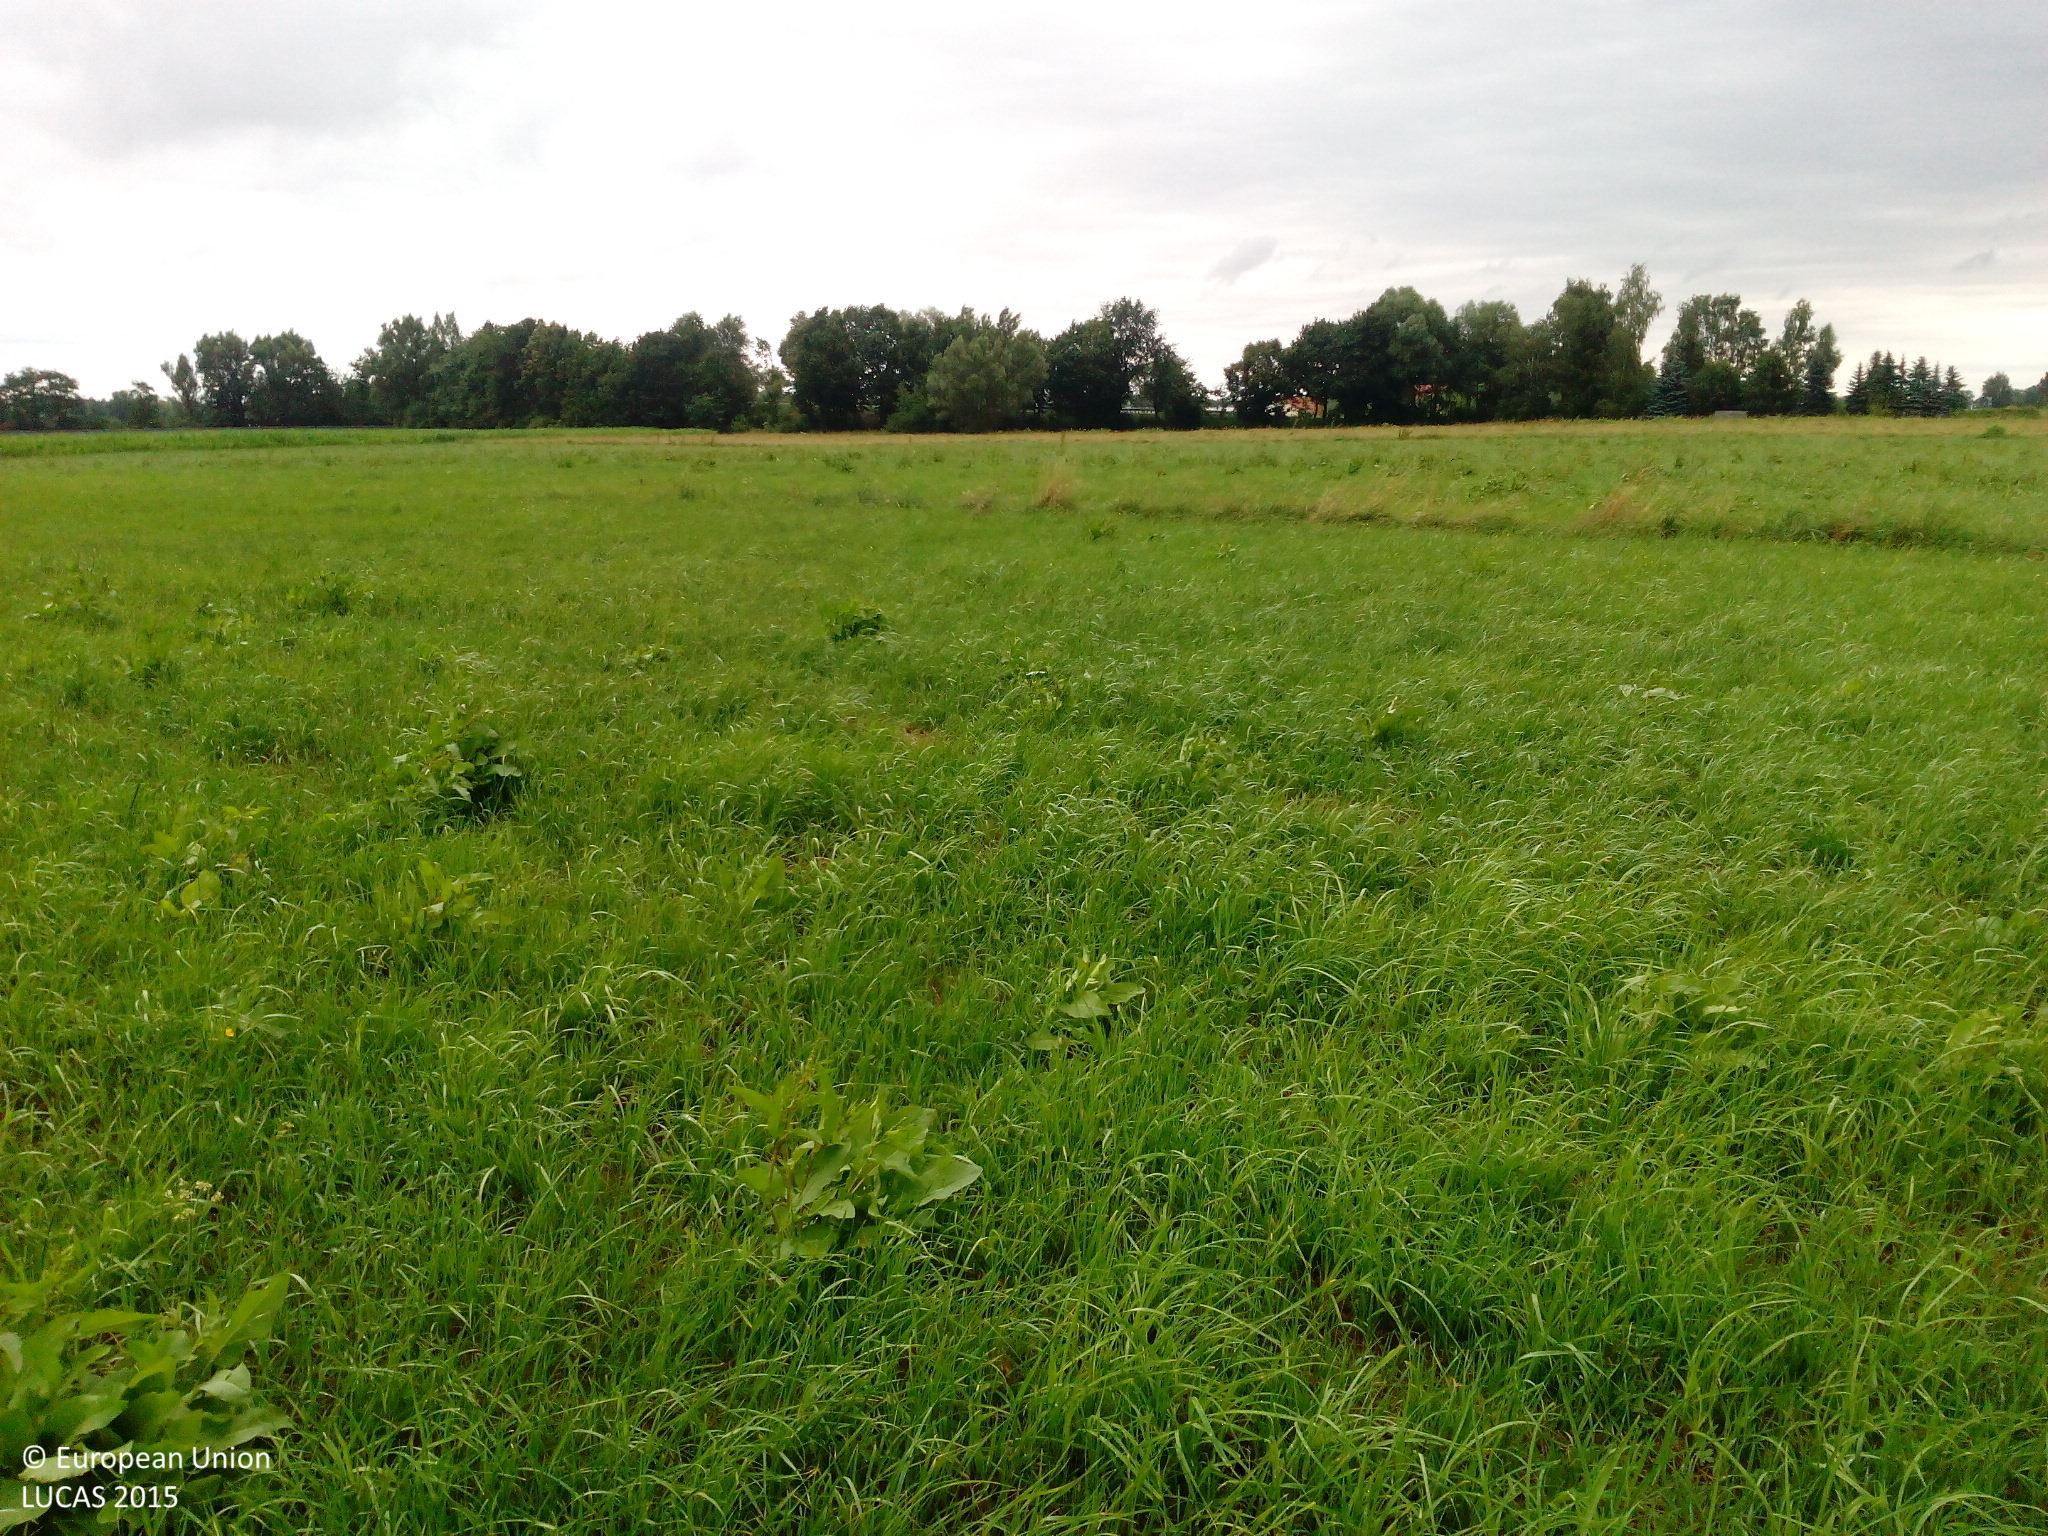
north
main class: Grassland
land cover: Grassland without tree/shrub cover
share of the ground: > 75 %
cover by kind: herbaceous plants 80 %, unconsolidated bare surface 15 %, lichens and mosses 5 %
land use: Agriculture (excluding fallow land and kitchen gardens)
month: July
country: DE
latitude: 48.6455
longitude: 11.4787
